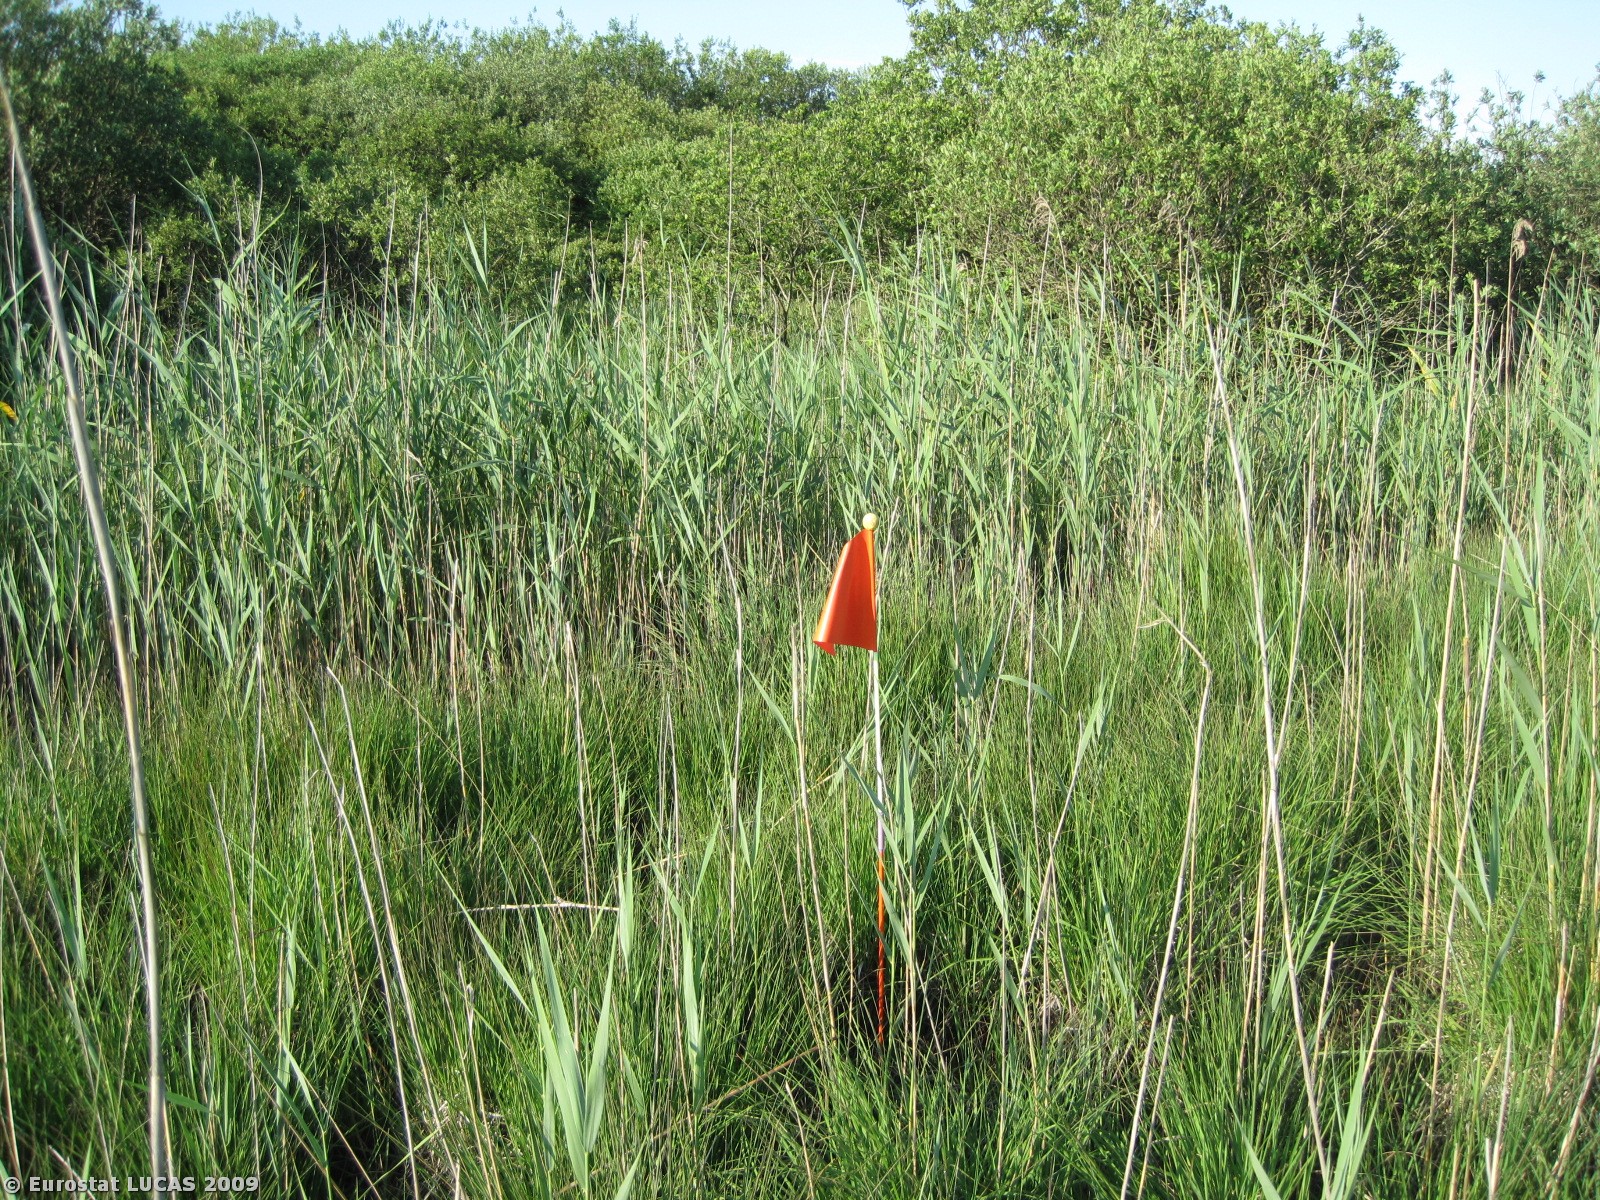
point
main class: Wetlands
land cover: Inland marshes
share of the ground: > 75 %
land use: Unused
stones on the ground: < 10 %
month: July
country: DK
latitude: 56.3739
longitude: 8.2695
